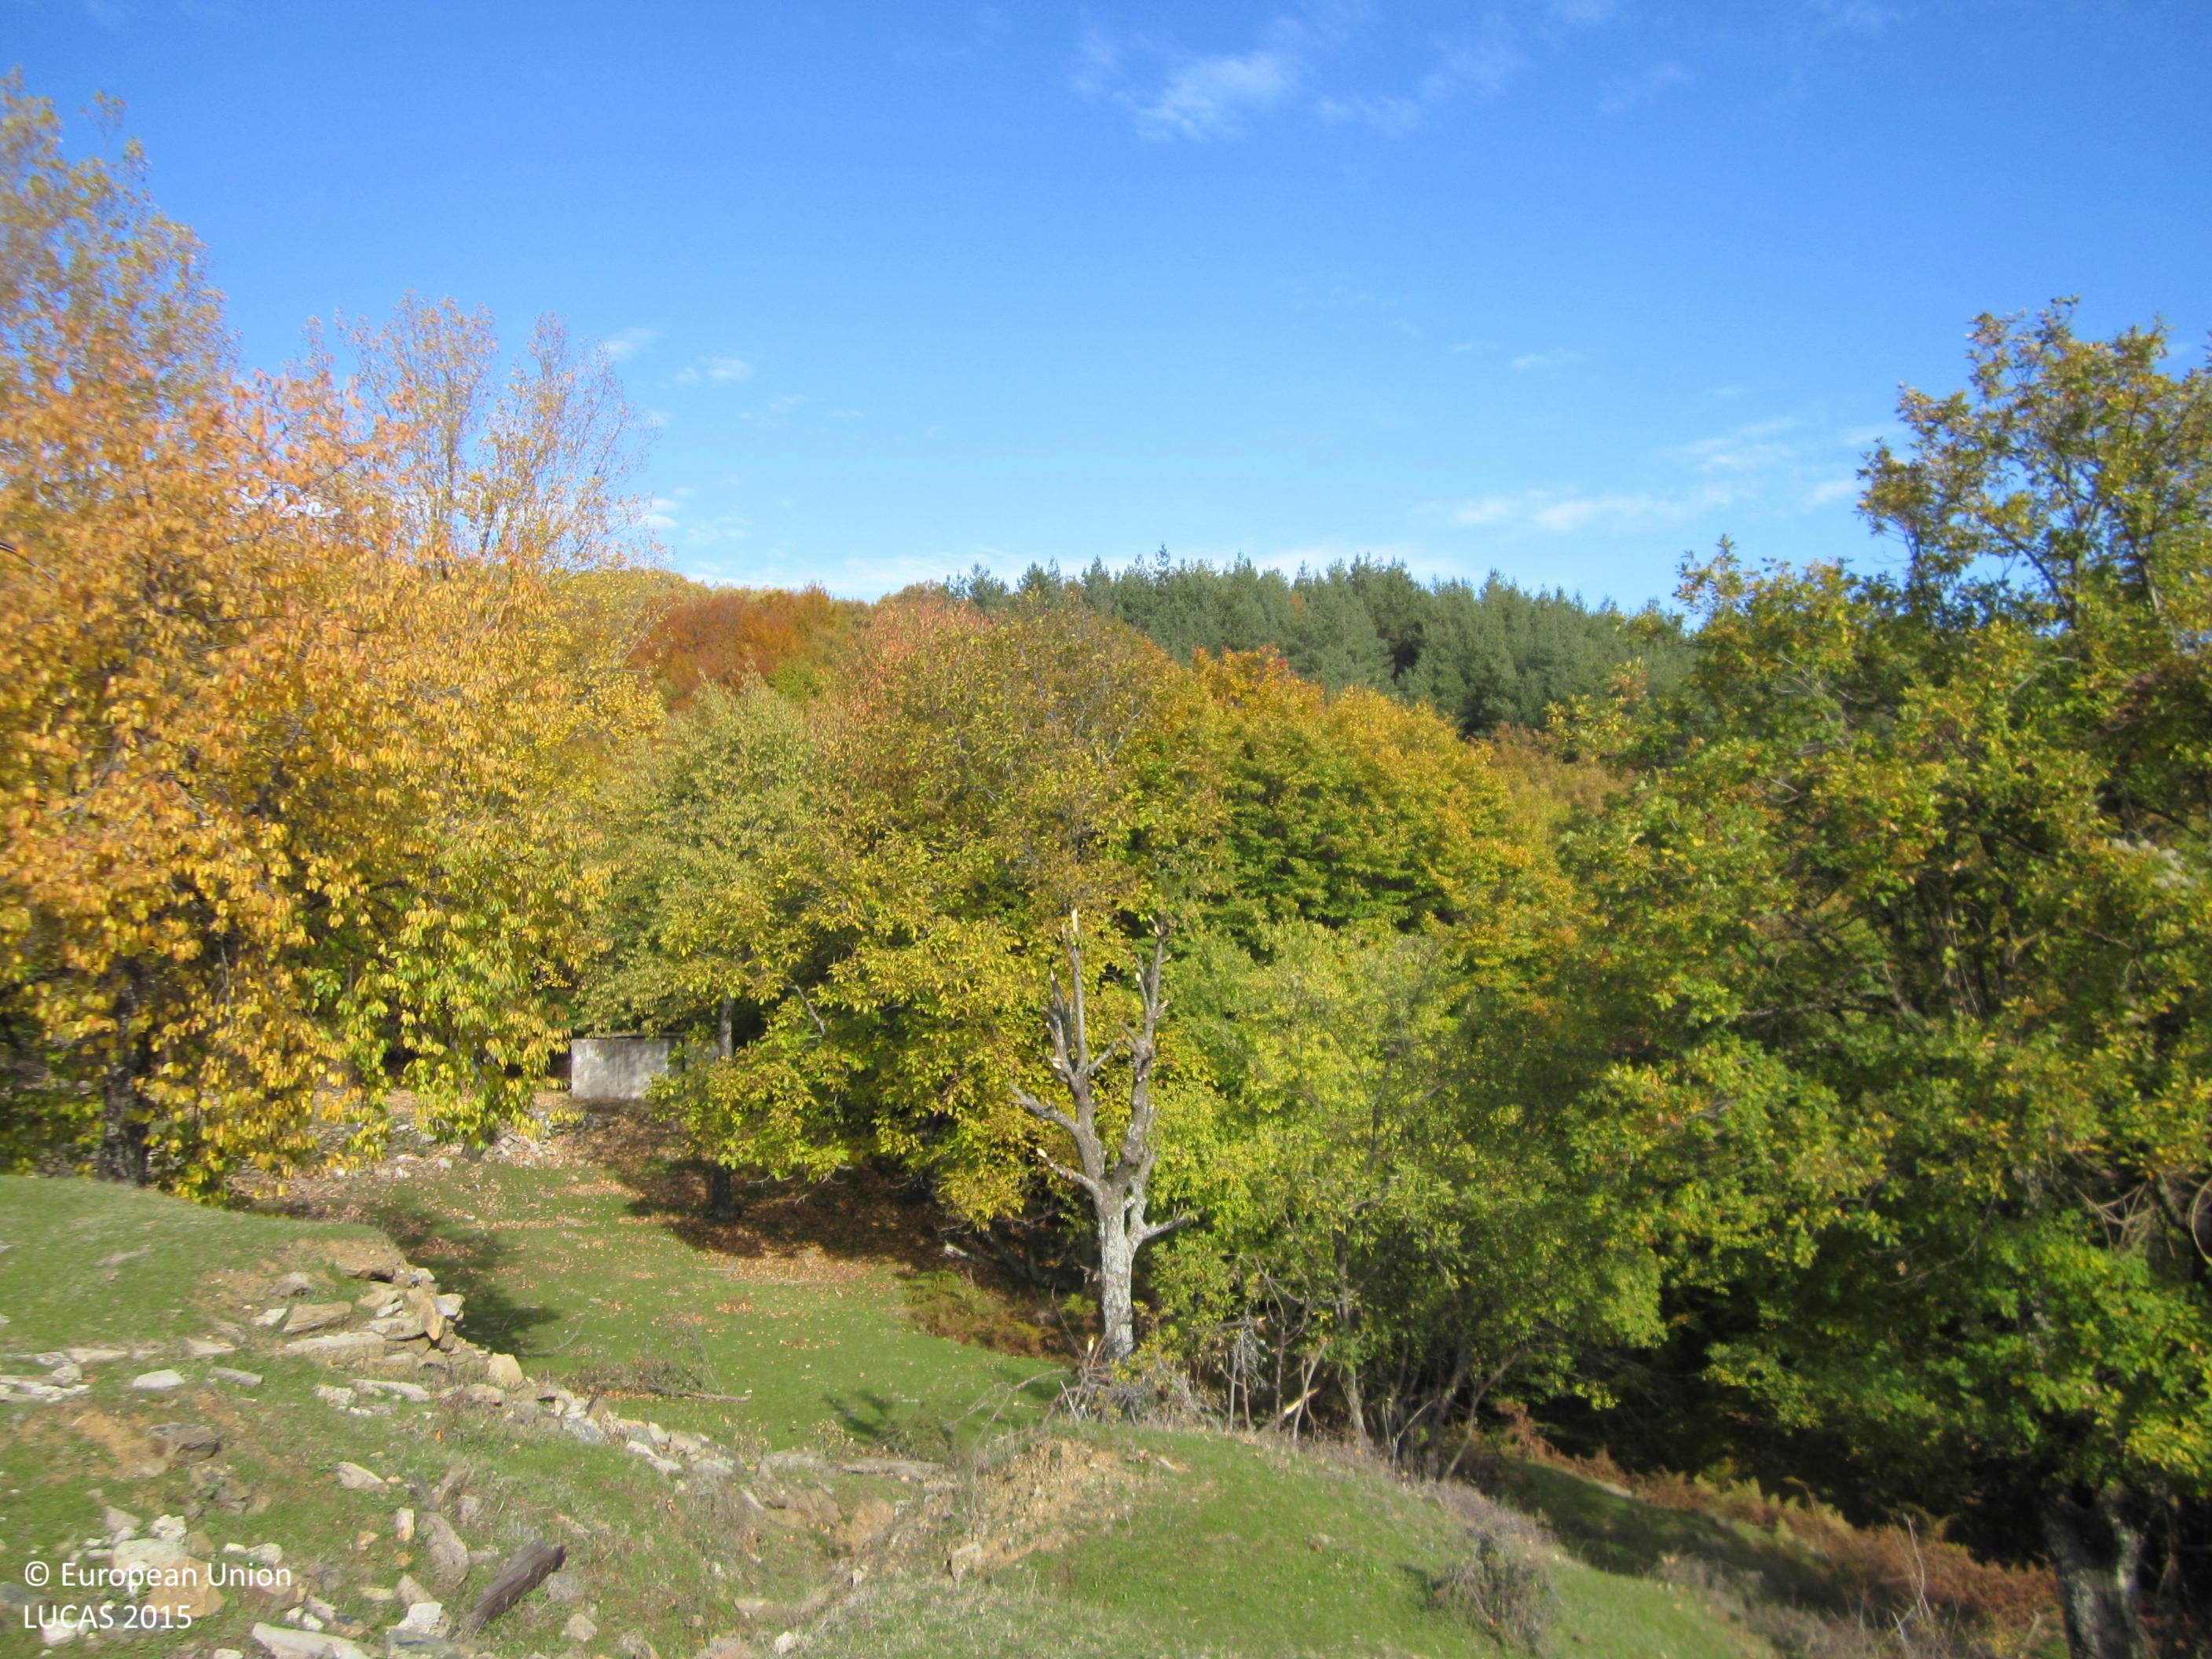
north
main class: Woodland
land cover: Pine dominated coniferous woodland
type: acidophilous oak and oak-birch forest
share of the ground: > 75 %
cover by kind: coniferous forest trees 100 %
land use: Forestry
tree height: > 5 m
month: November
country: BG
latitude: 41.3151
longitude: 25.6713
